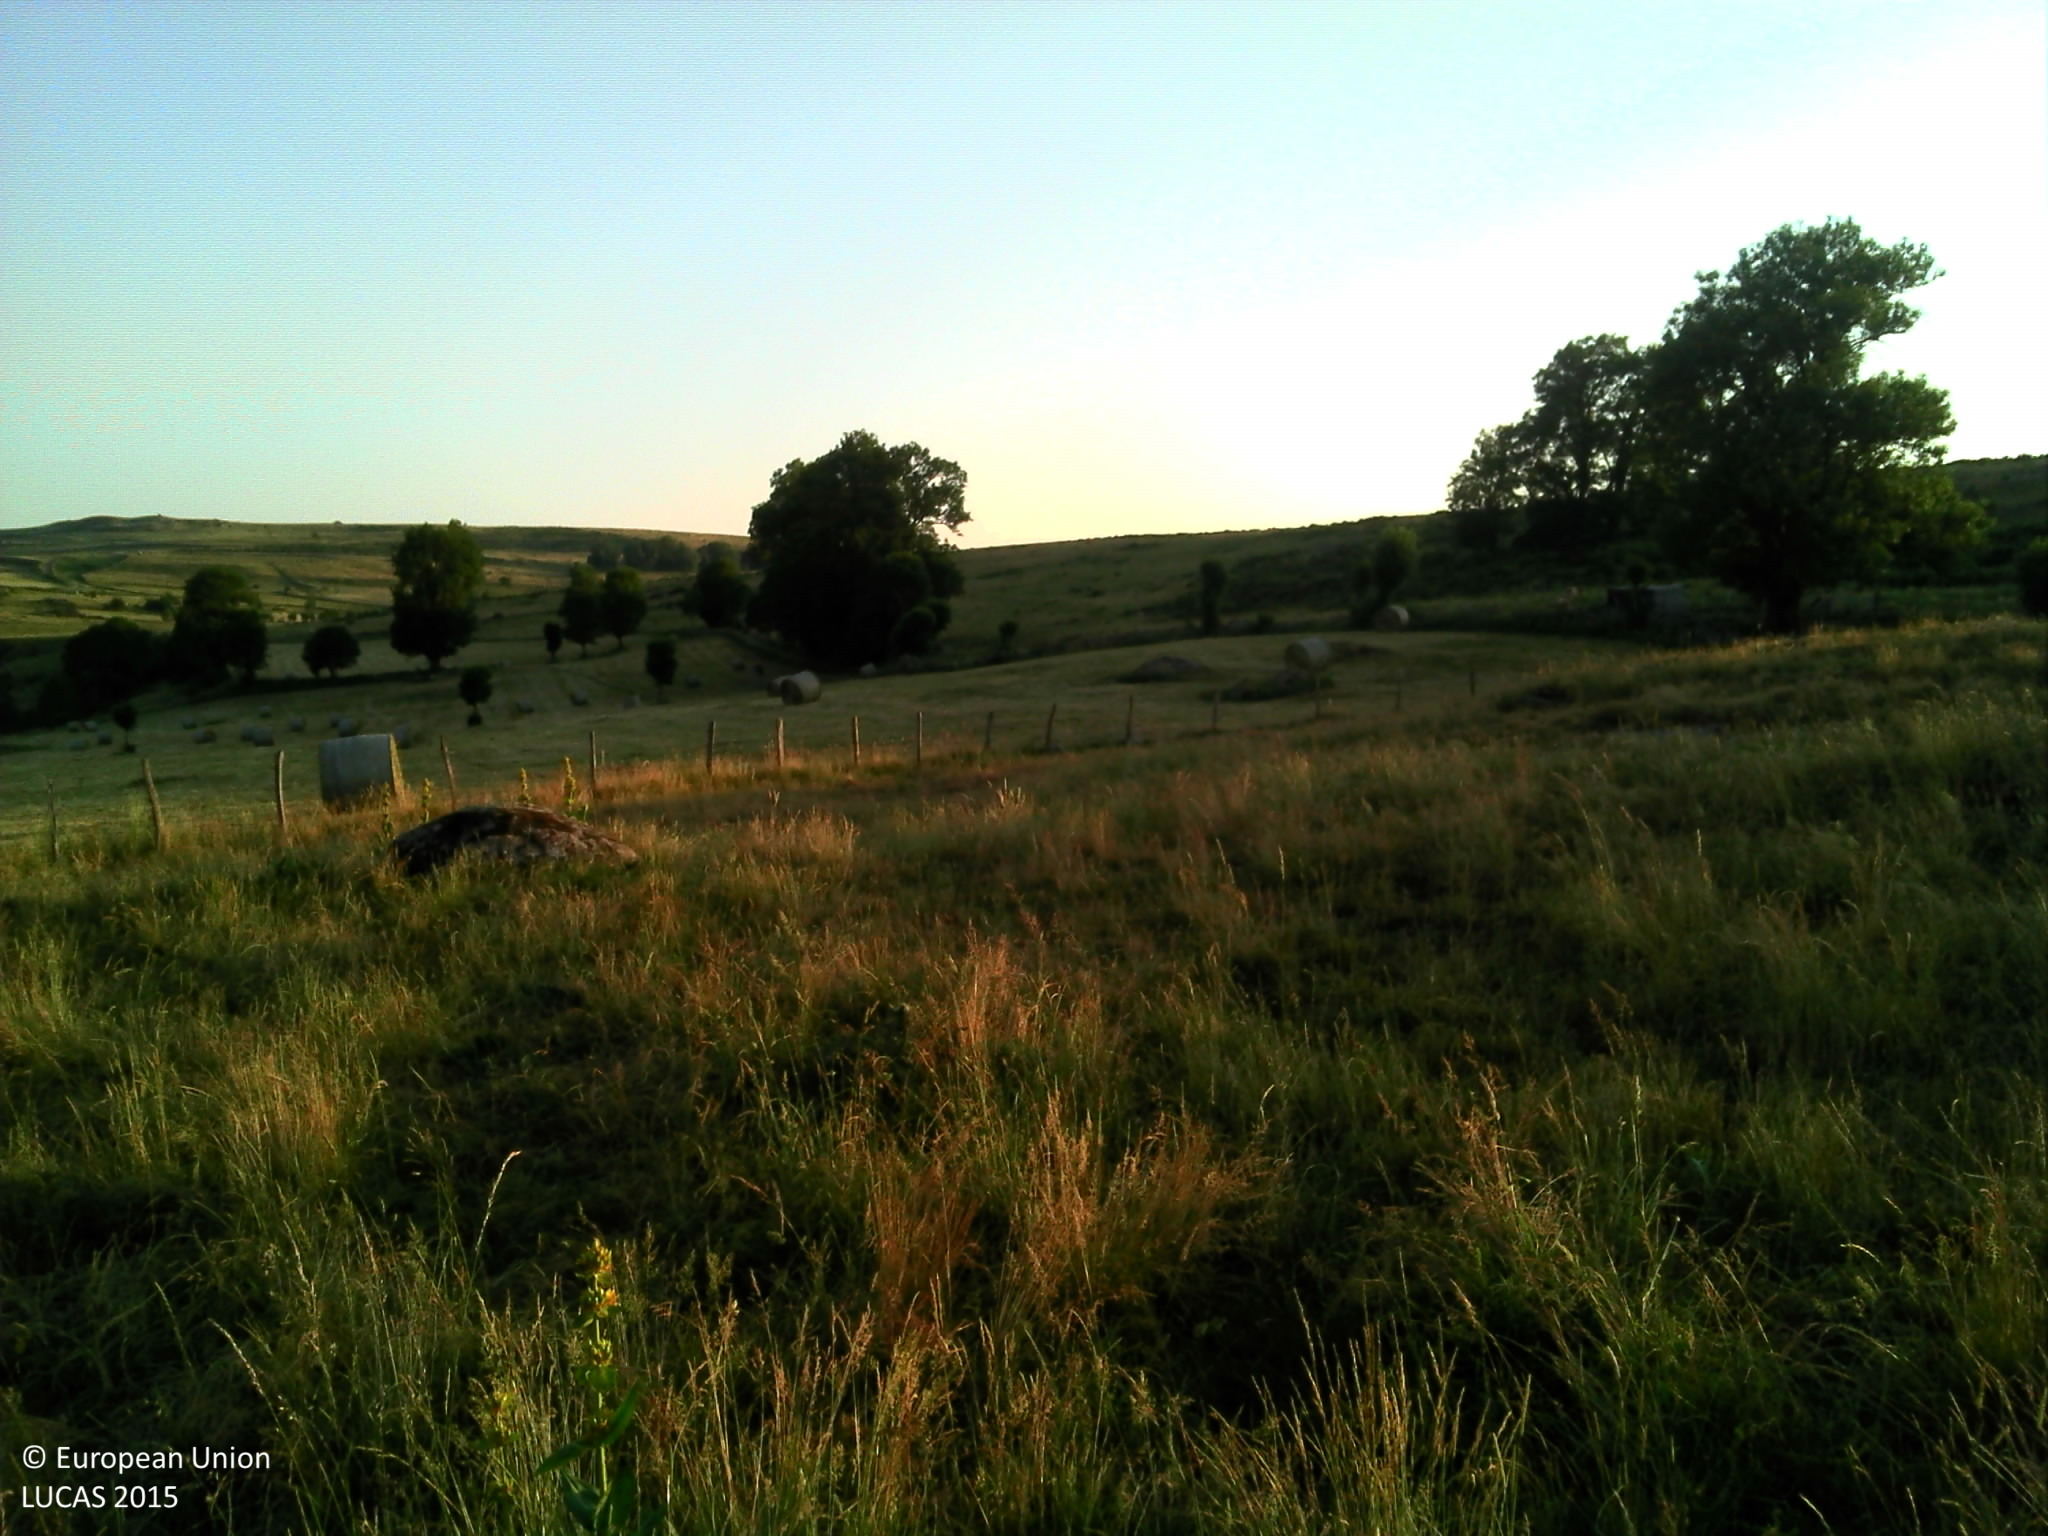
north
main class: Grassland
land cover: Grassland without tree/shrub cover
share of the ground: > 75 %
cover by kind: herbaceous plants 100 %
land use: Agriculture (excluding fallow land and kitchen gardens)
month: July
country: FR
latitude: 44.7306
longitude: 3.0206
